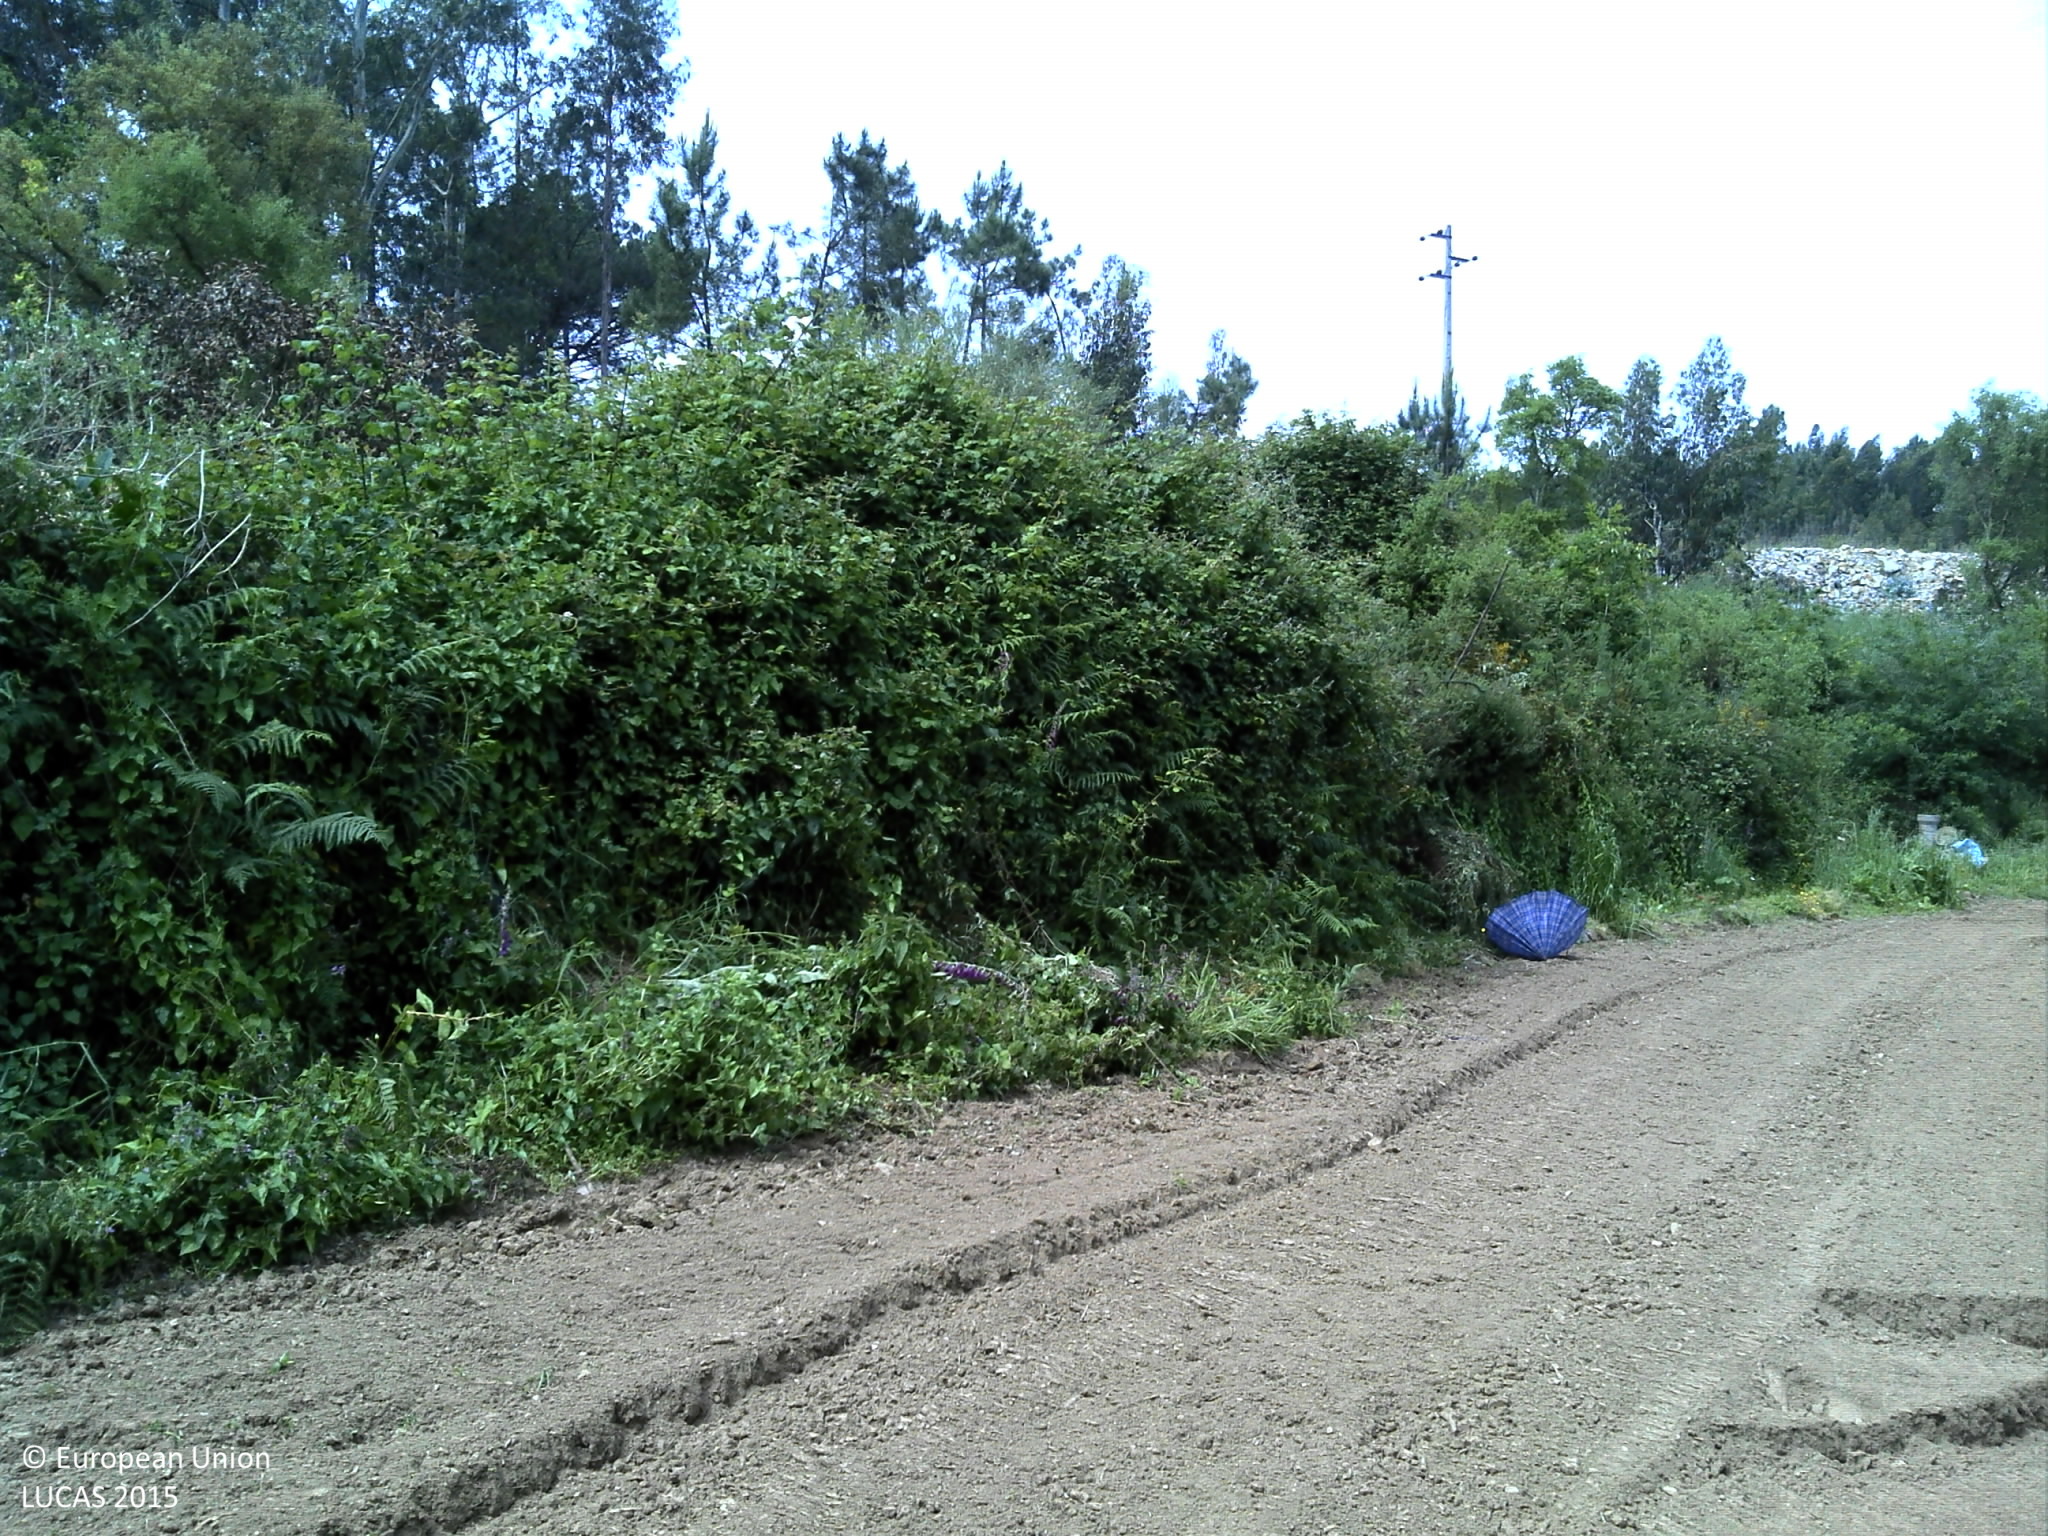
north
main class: Woodland
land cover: Broadleaved woodland
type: thermophilous deciduous forest
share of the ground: > 75 %
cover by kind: broadleaved forest trees 75 %, shrubs 20 %, unconsolidated bare surface 5 %
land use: Forestry
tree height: > 5 m
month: May
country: PT
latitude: 41.1341
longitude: -8.5067
